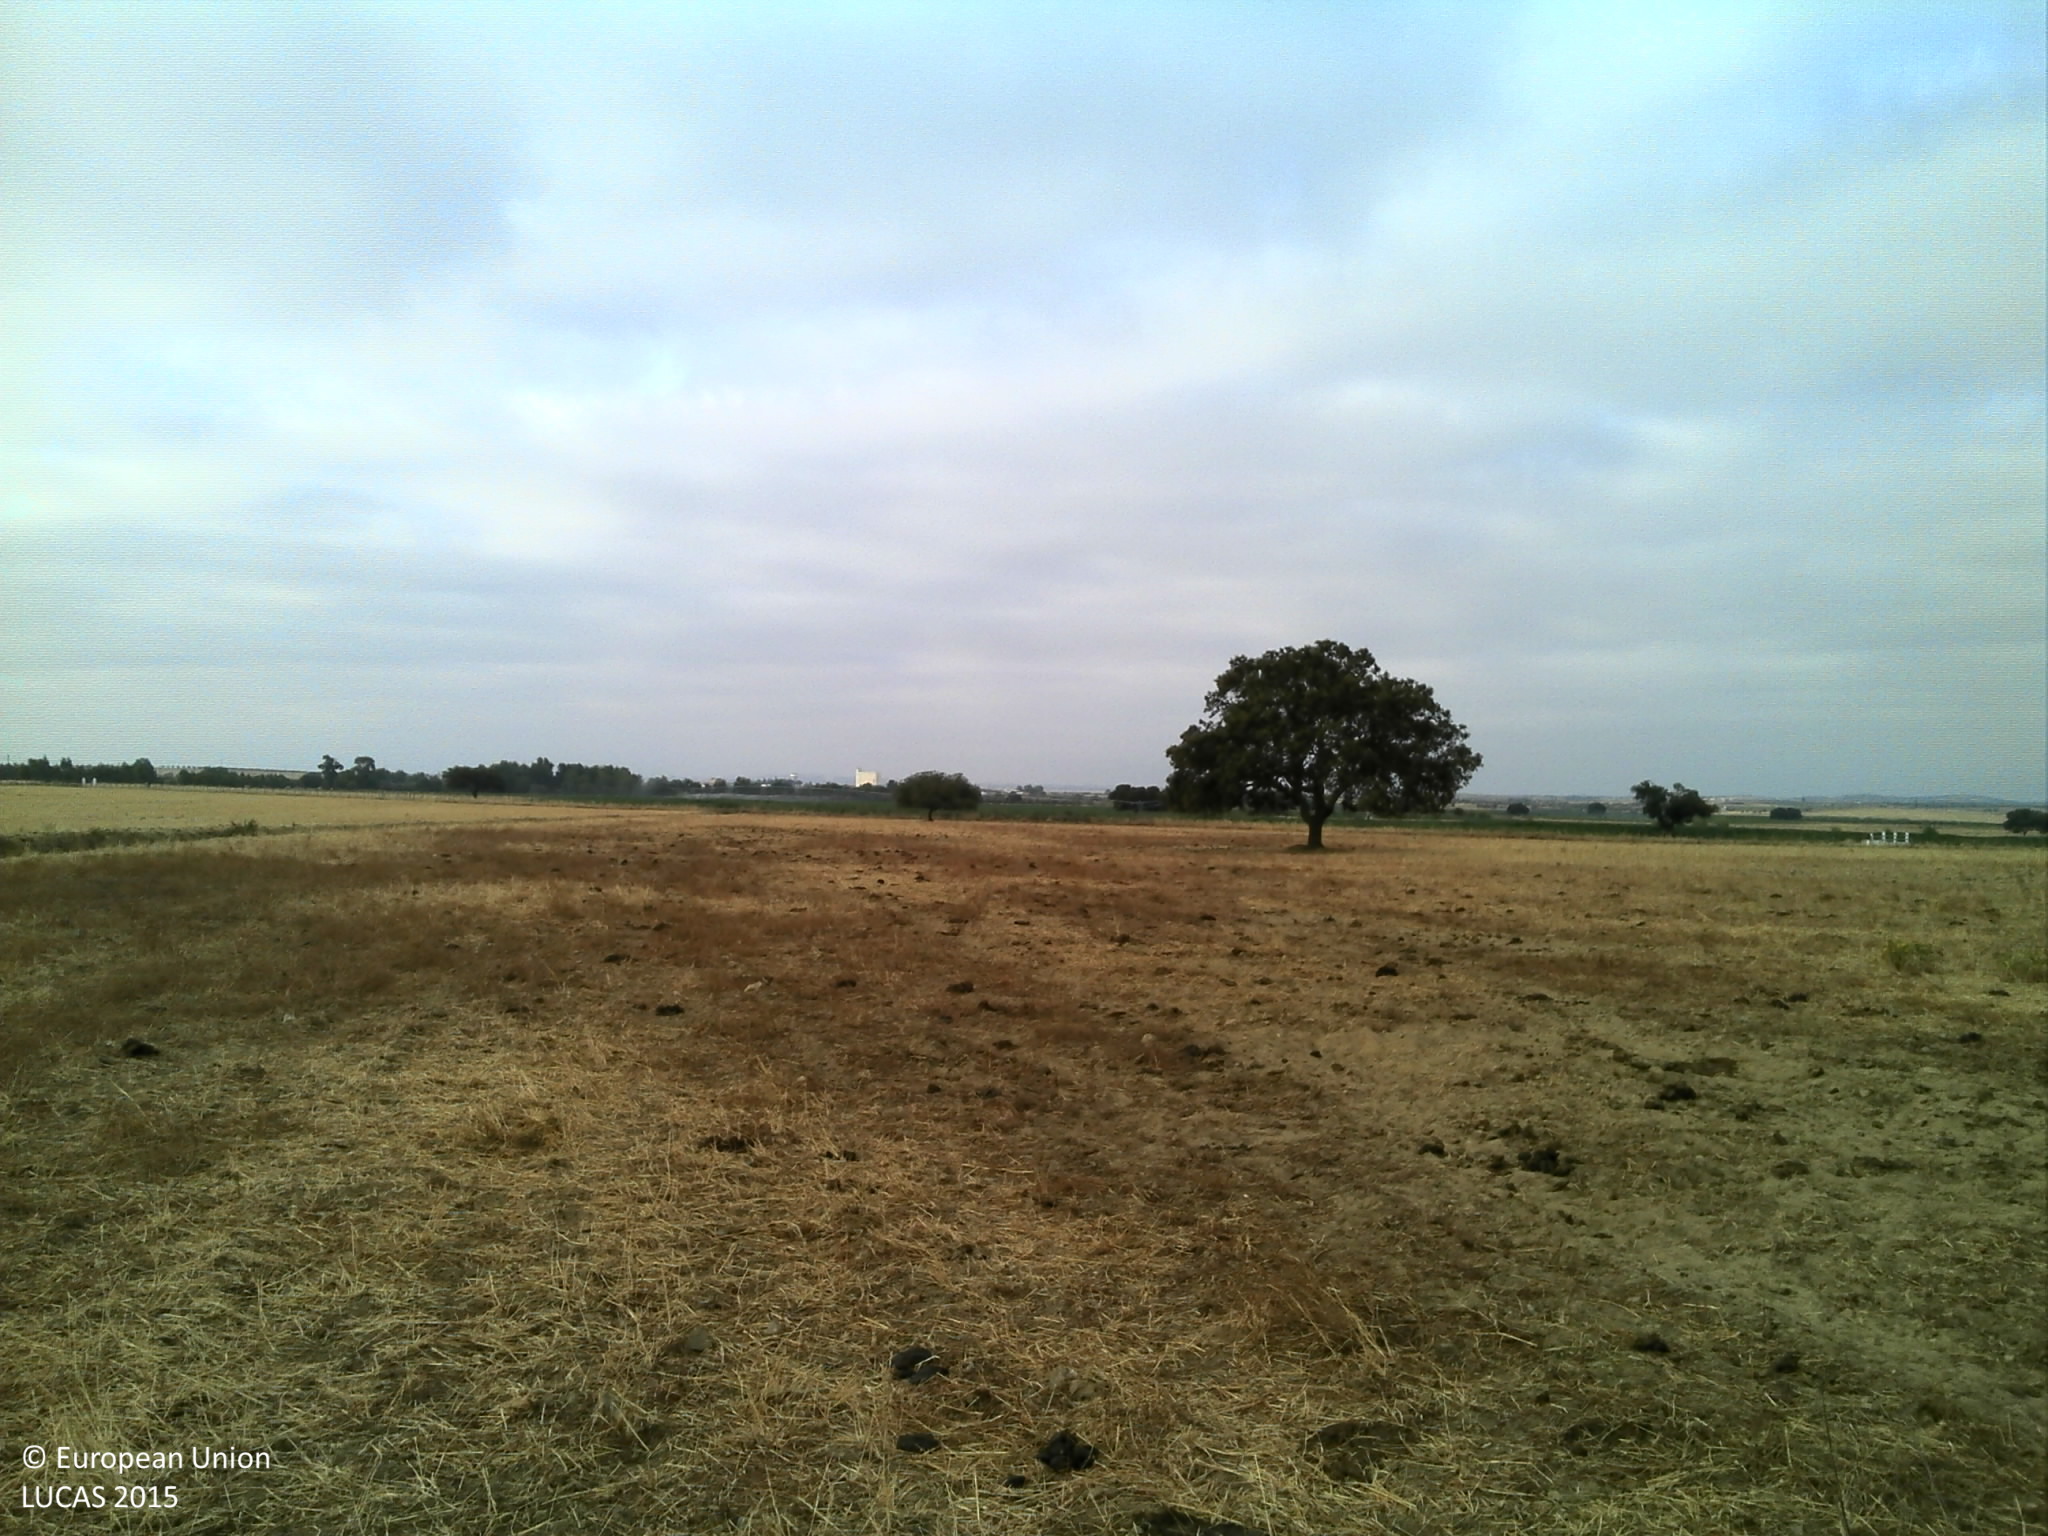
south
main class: Grassland
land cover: Grassland without tree/shrub cover
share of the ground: 10 - 25 %
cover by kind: unconsolidated bare surface 90 %, herbaceous plants 10 %
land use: Agriculture (excluding fallow land and kitchen gardens)
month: June
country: PT
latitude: 38.1987
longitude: -7.9028
